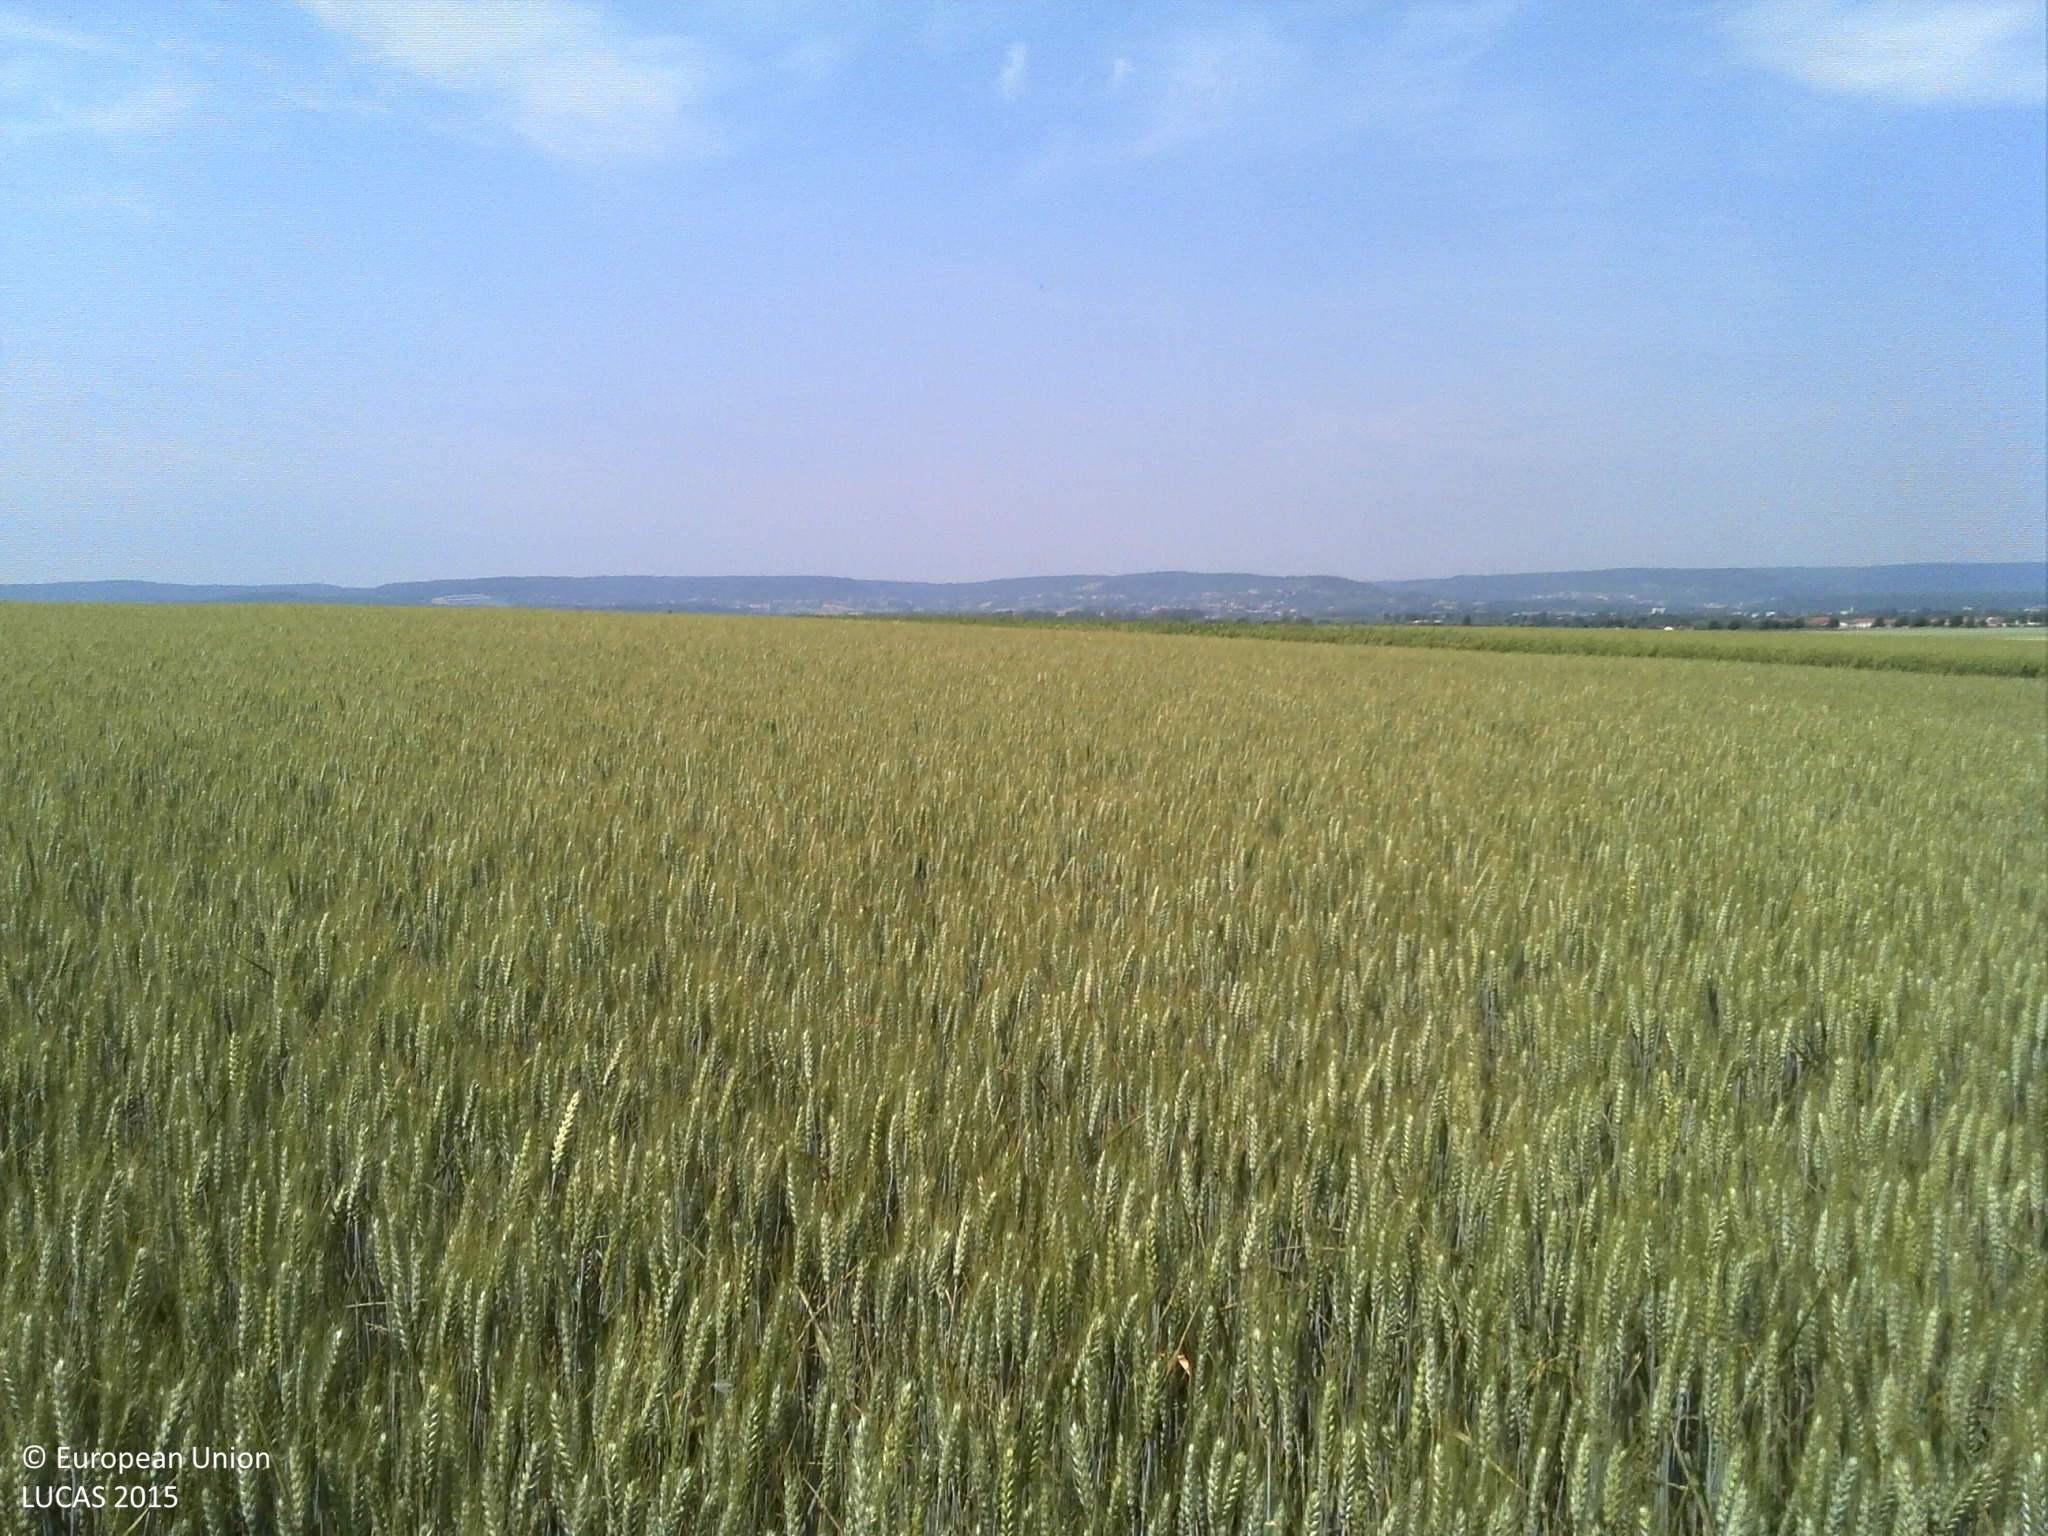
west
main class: Cropland
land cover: Common wheat
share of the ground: > 75 %
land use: Agriculture (excluding fallow land and kitchen gardens)
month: June
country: FR
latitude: 49.1856
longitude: 6.2267
